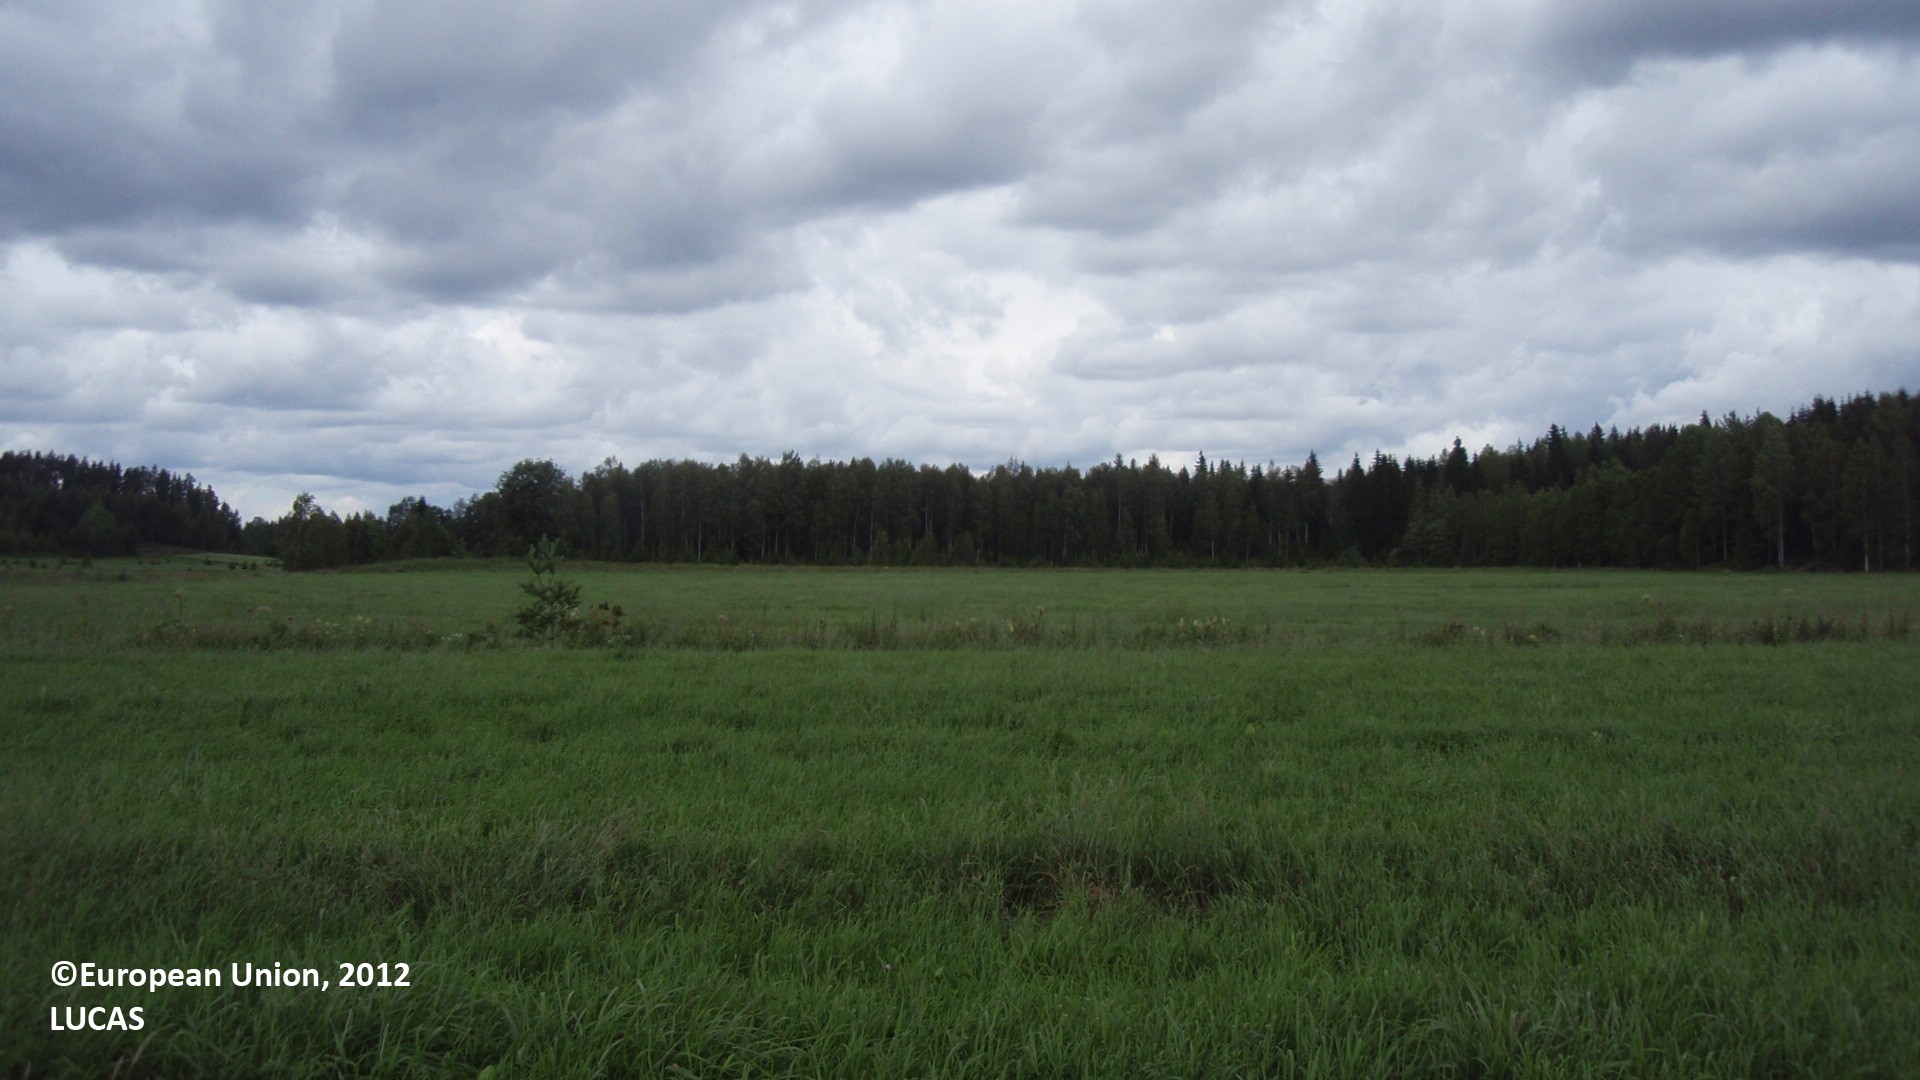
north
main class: Cropland
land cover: Temporary grasslands
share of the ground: > 75 %
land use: Agriculture (excluding fallow land and kitchen gardens)
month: July
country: FI
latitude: 61.3593
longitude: 28.7569
